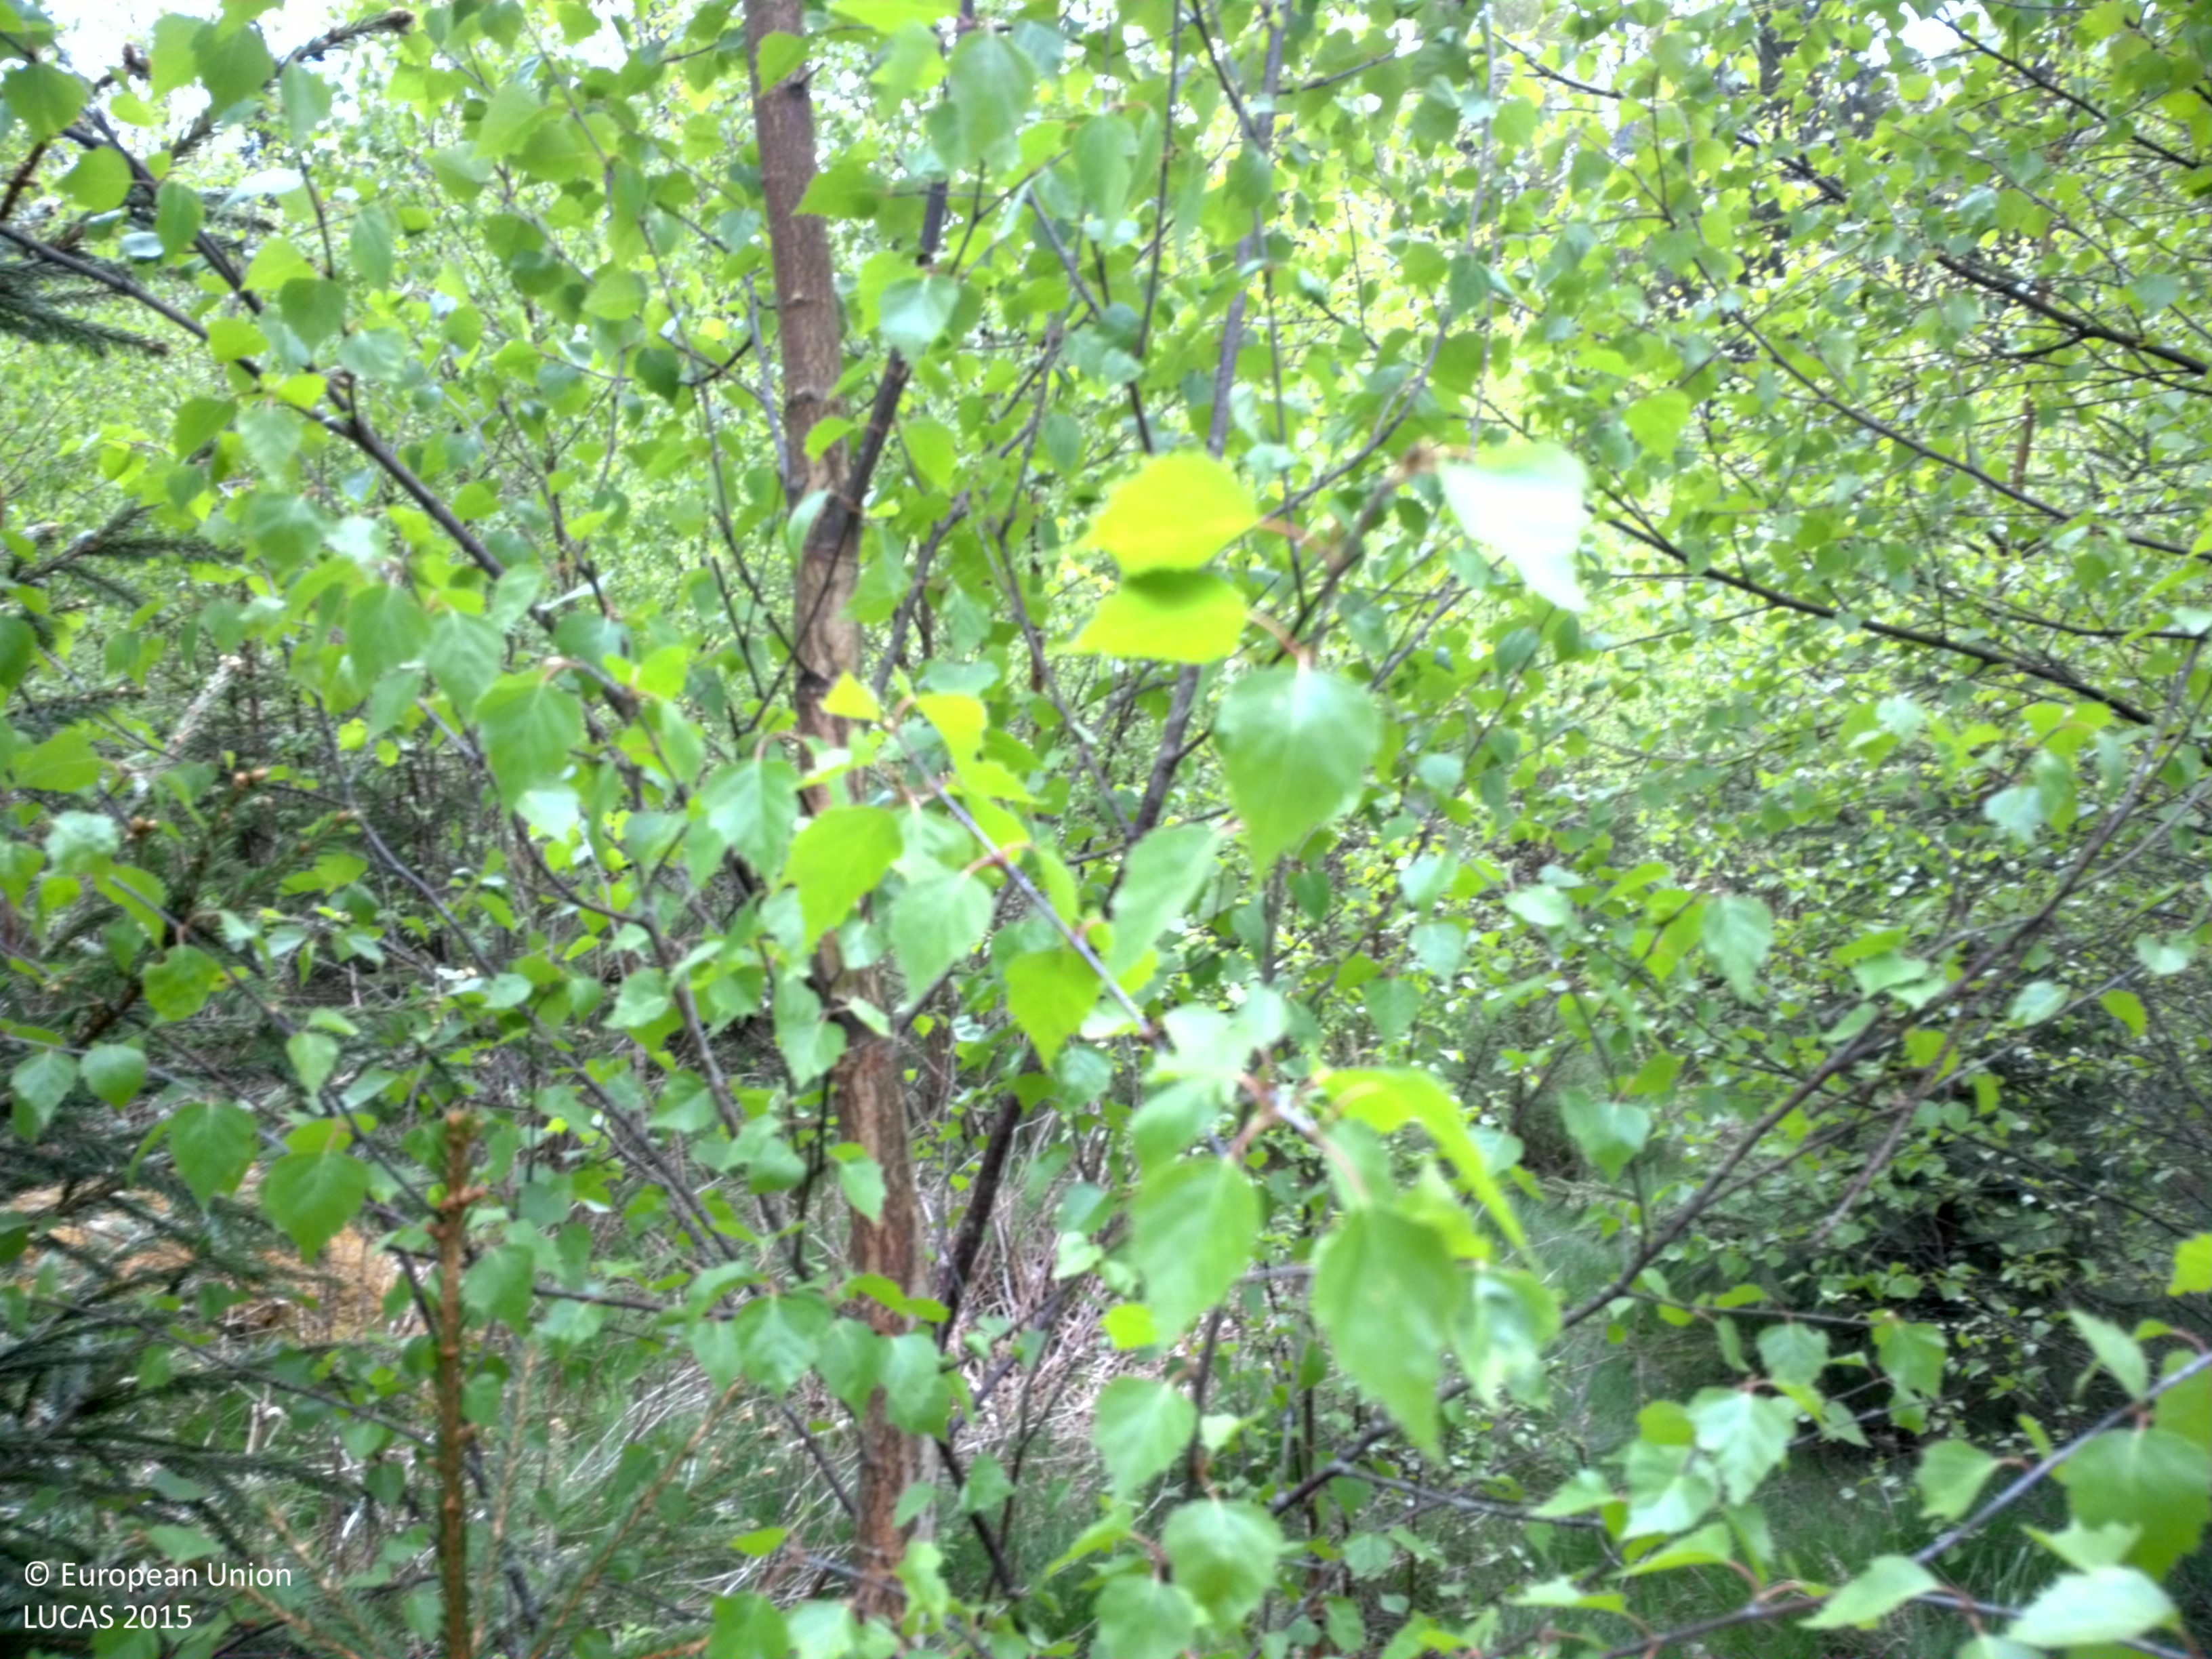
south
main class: Woodland
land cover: Broadleaved woodland
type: boreal forest
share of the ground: > 75 %
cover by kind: broadleaved forest trees 85 %, herbaceous plants 10 %, coniferous forest trees 5 %
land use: Forestry
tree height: < 5 m
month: May
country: SE
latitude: 56.7392
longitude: 15.4424
